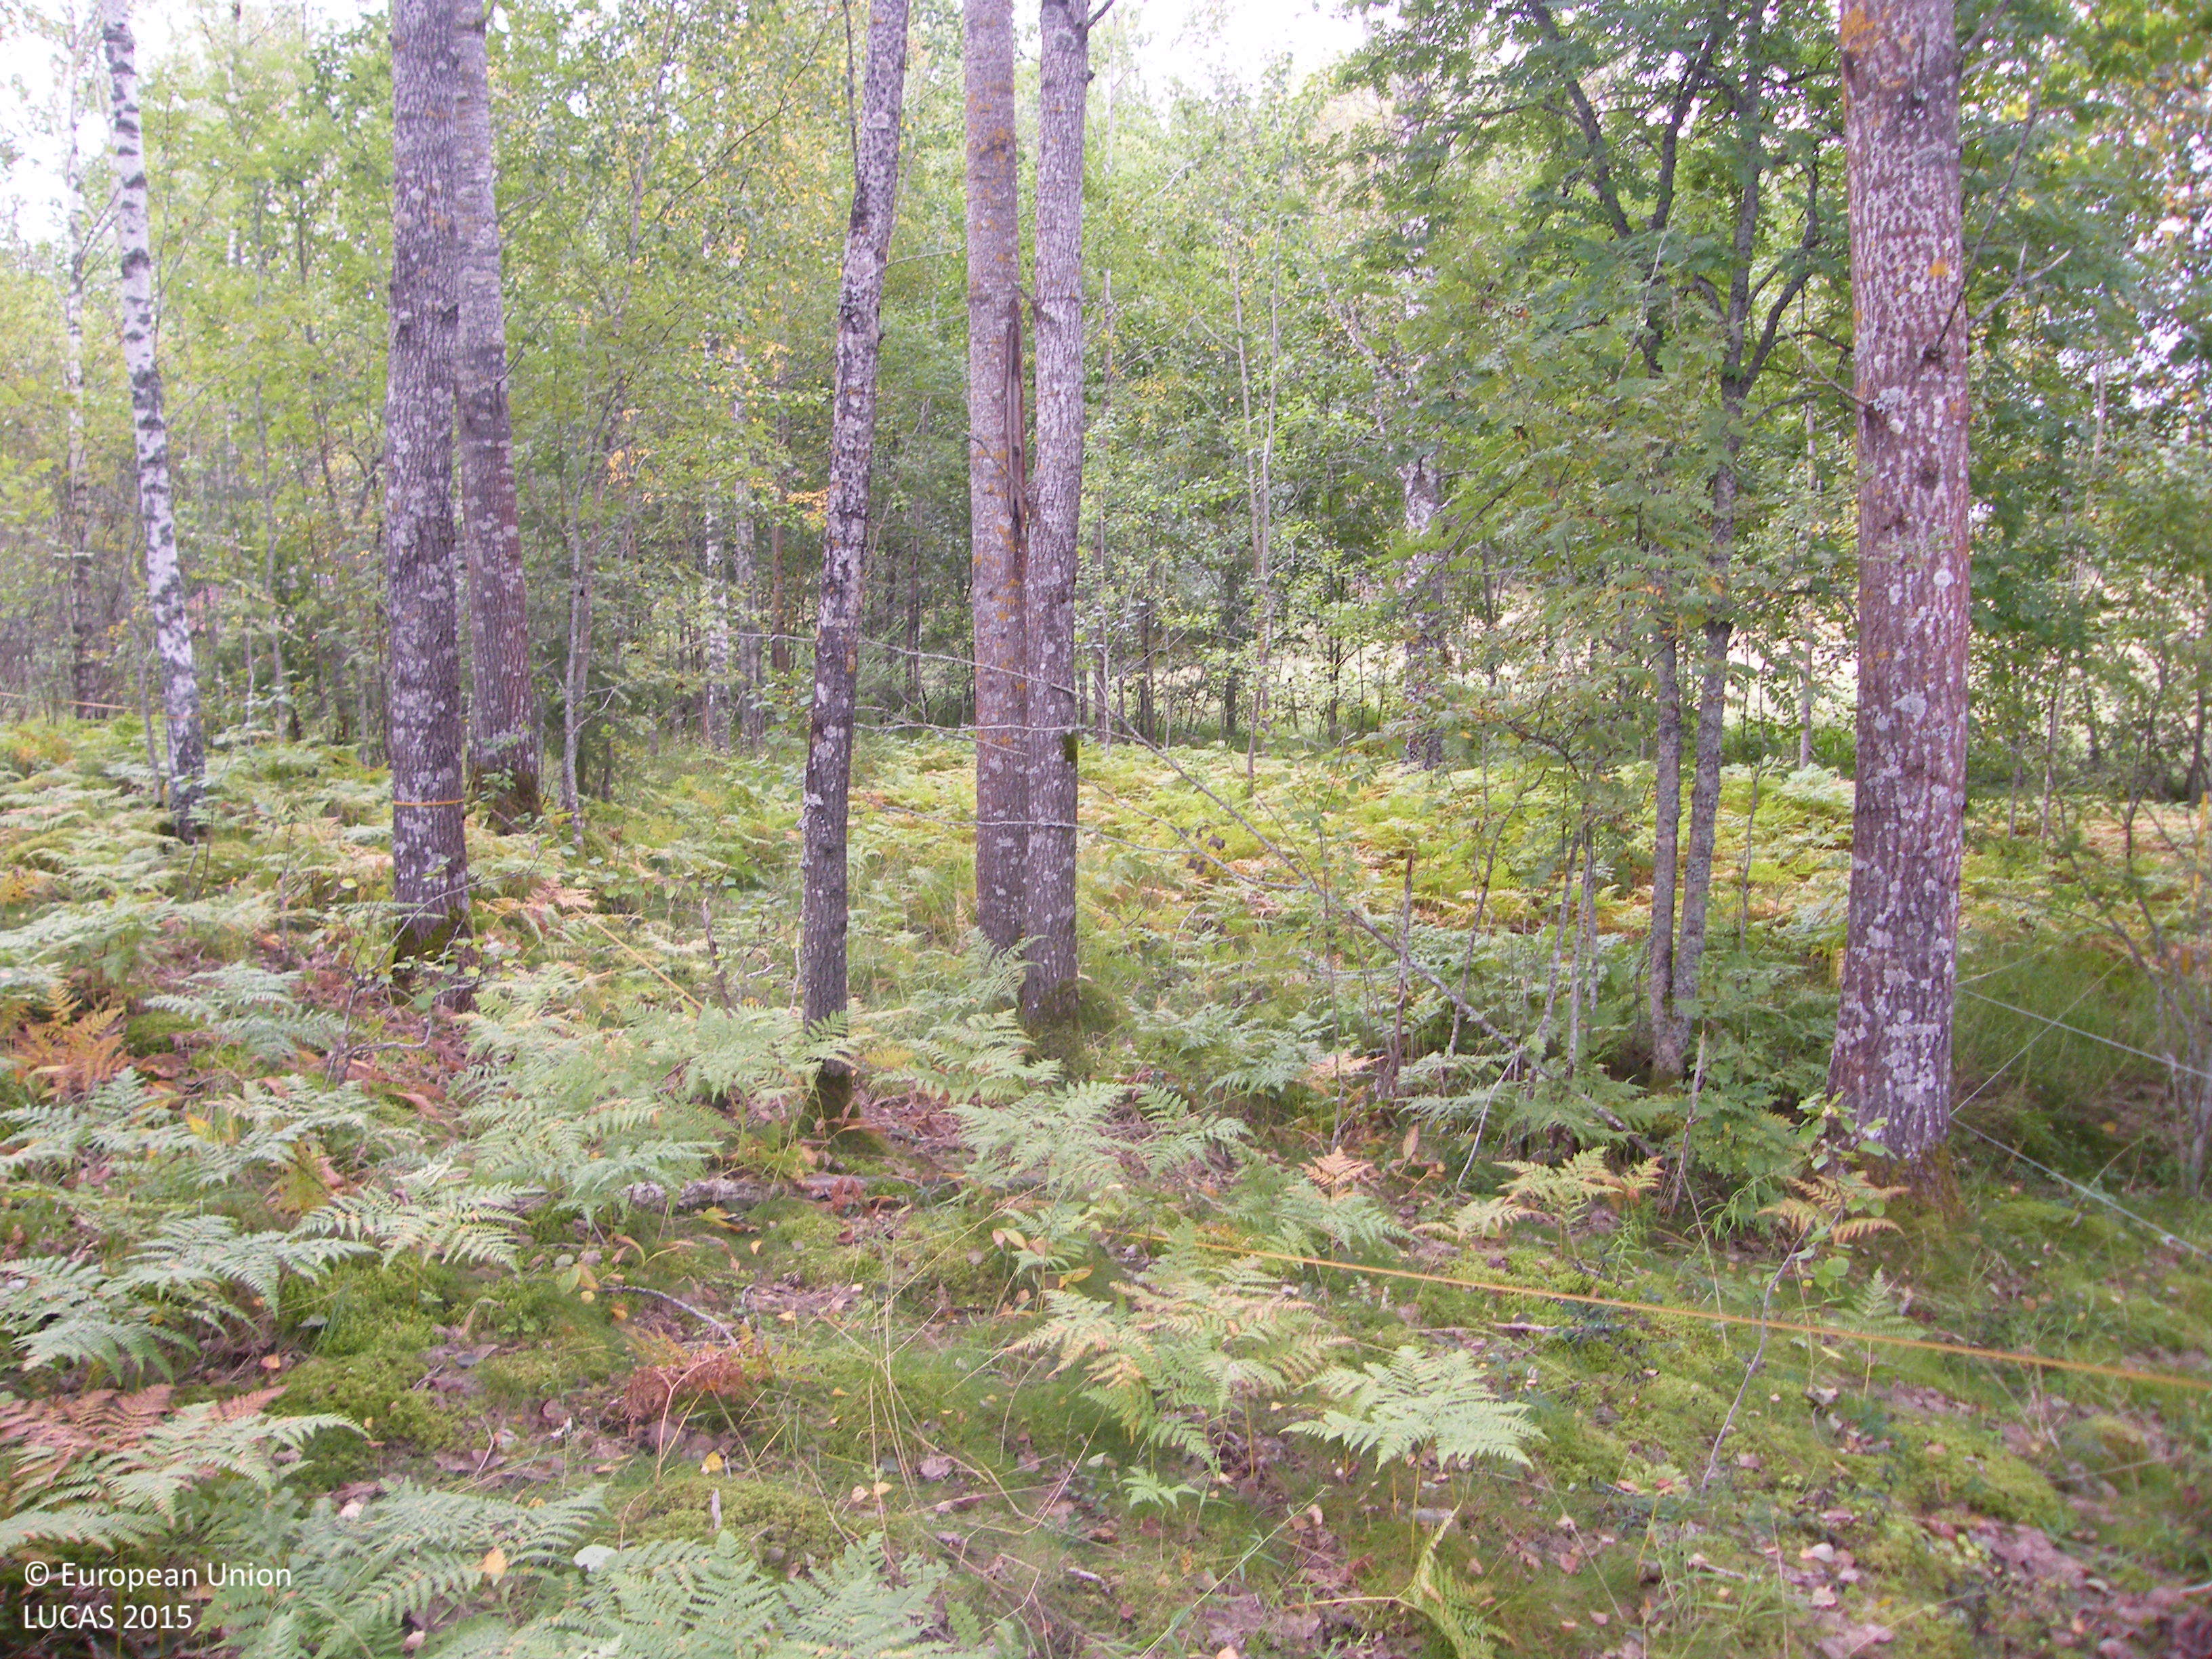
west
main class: Woodland
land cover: Broadleaved woodland
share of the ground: 50 - 75 %
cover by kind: broadleaved forest trees 65 %, herbaceous plants 20 %, lichens and mosses 10 %, shrubs 5 %
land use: Semi-natural and natural areas not in use
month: September
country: SE
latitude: 59.5282
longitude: 15.5953
